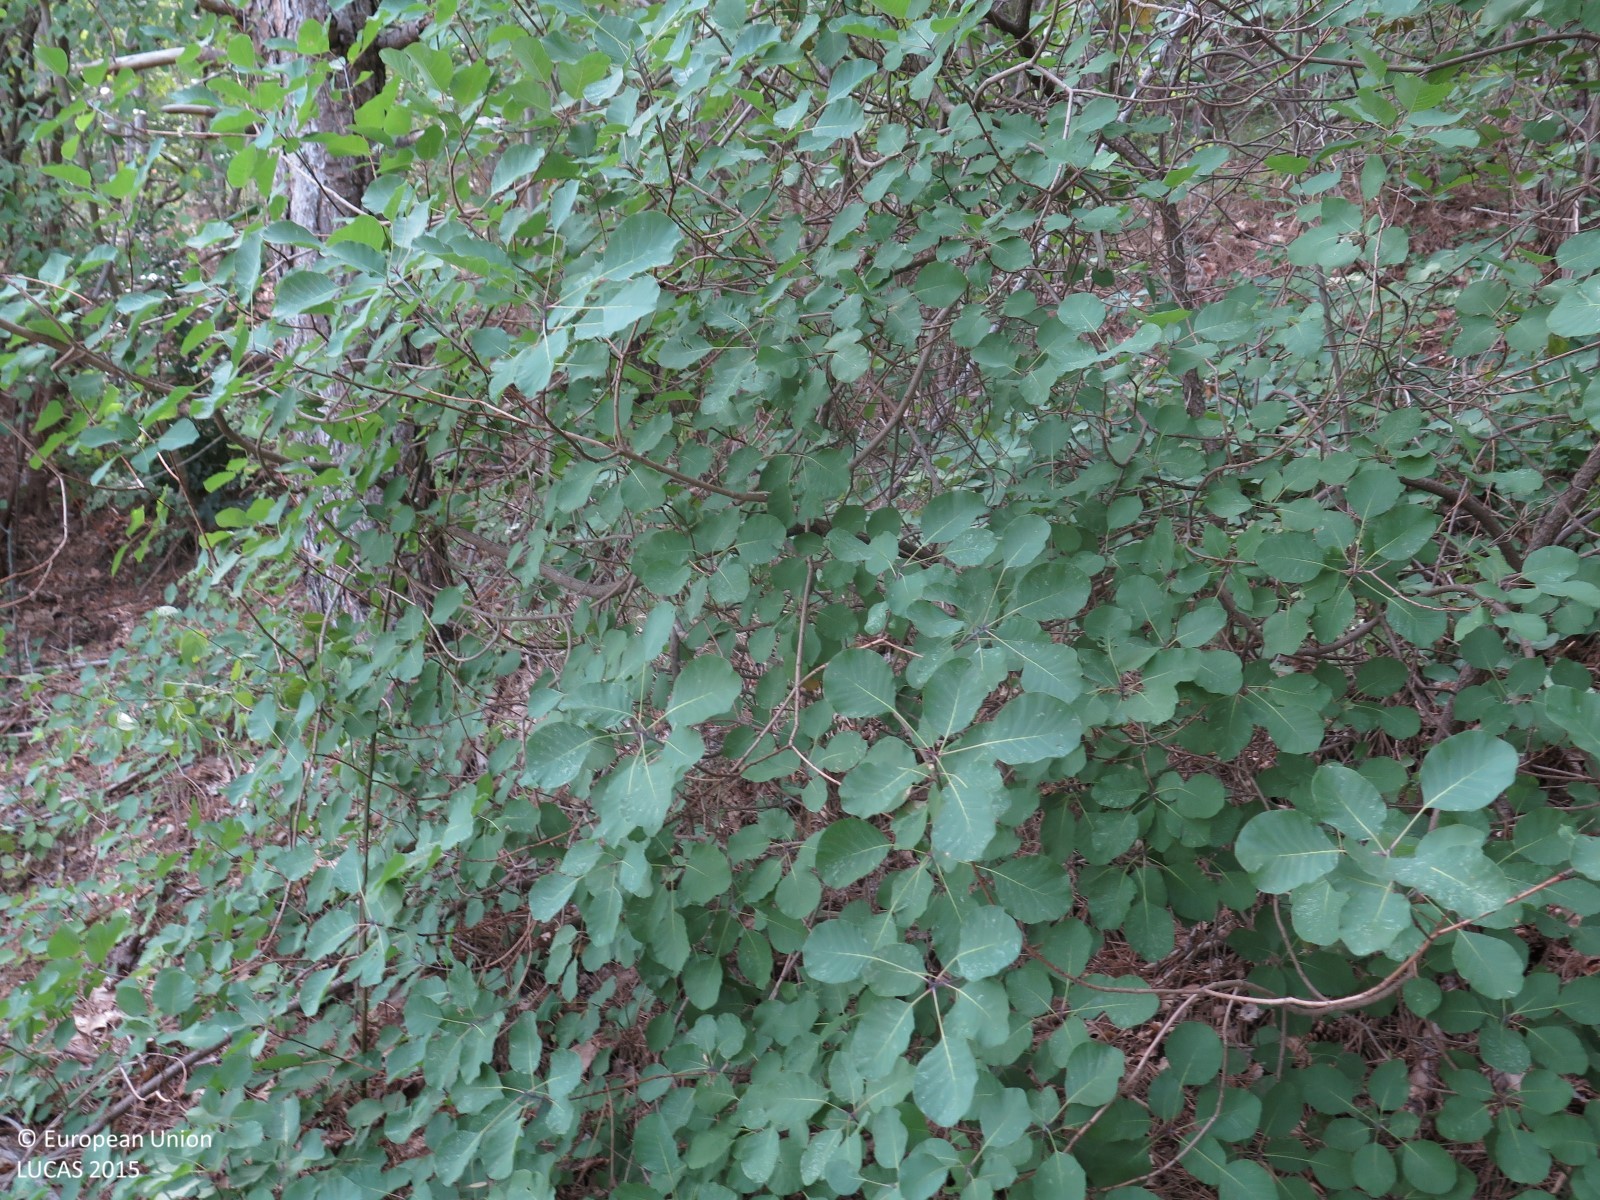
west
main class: Woodland
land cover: Pine dominated mixed woodland
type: coniferous forest of the mediterranean region
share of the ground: > 75 %
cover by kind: coniferous forest trees 75 %, broadleaved forest trees 25 %
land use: Semi-natural and natural areas not in use
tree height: > 5 m
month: July
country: HR
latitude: 45.2819
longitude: 14.0616
